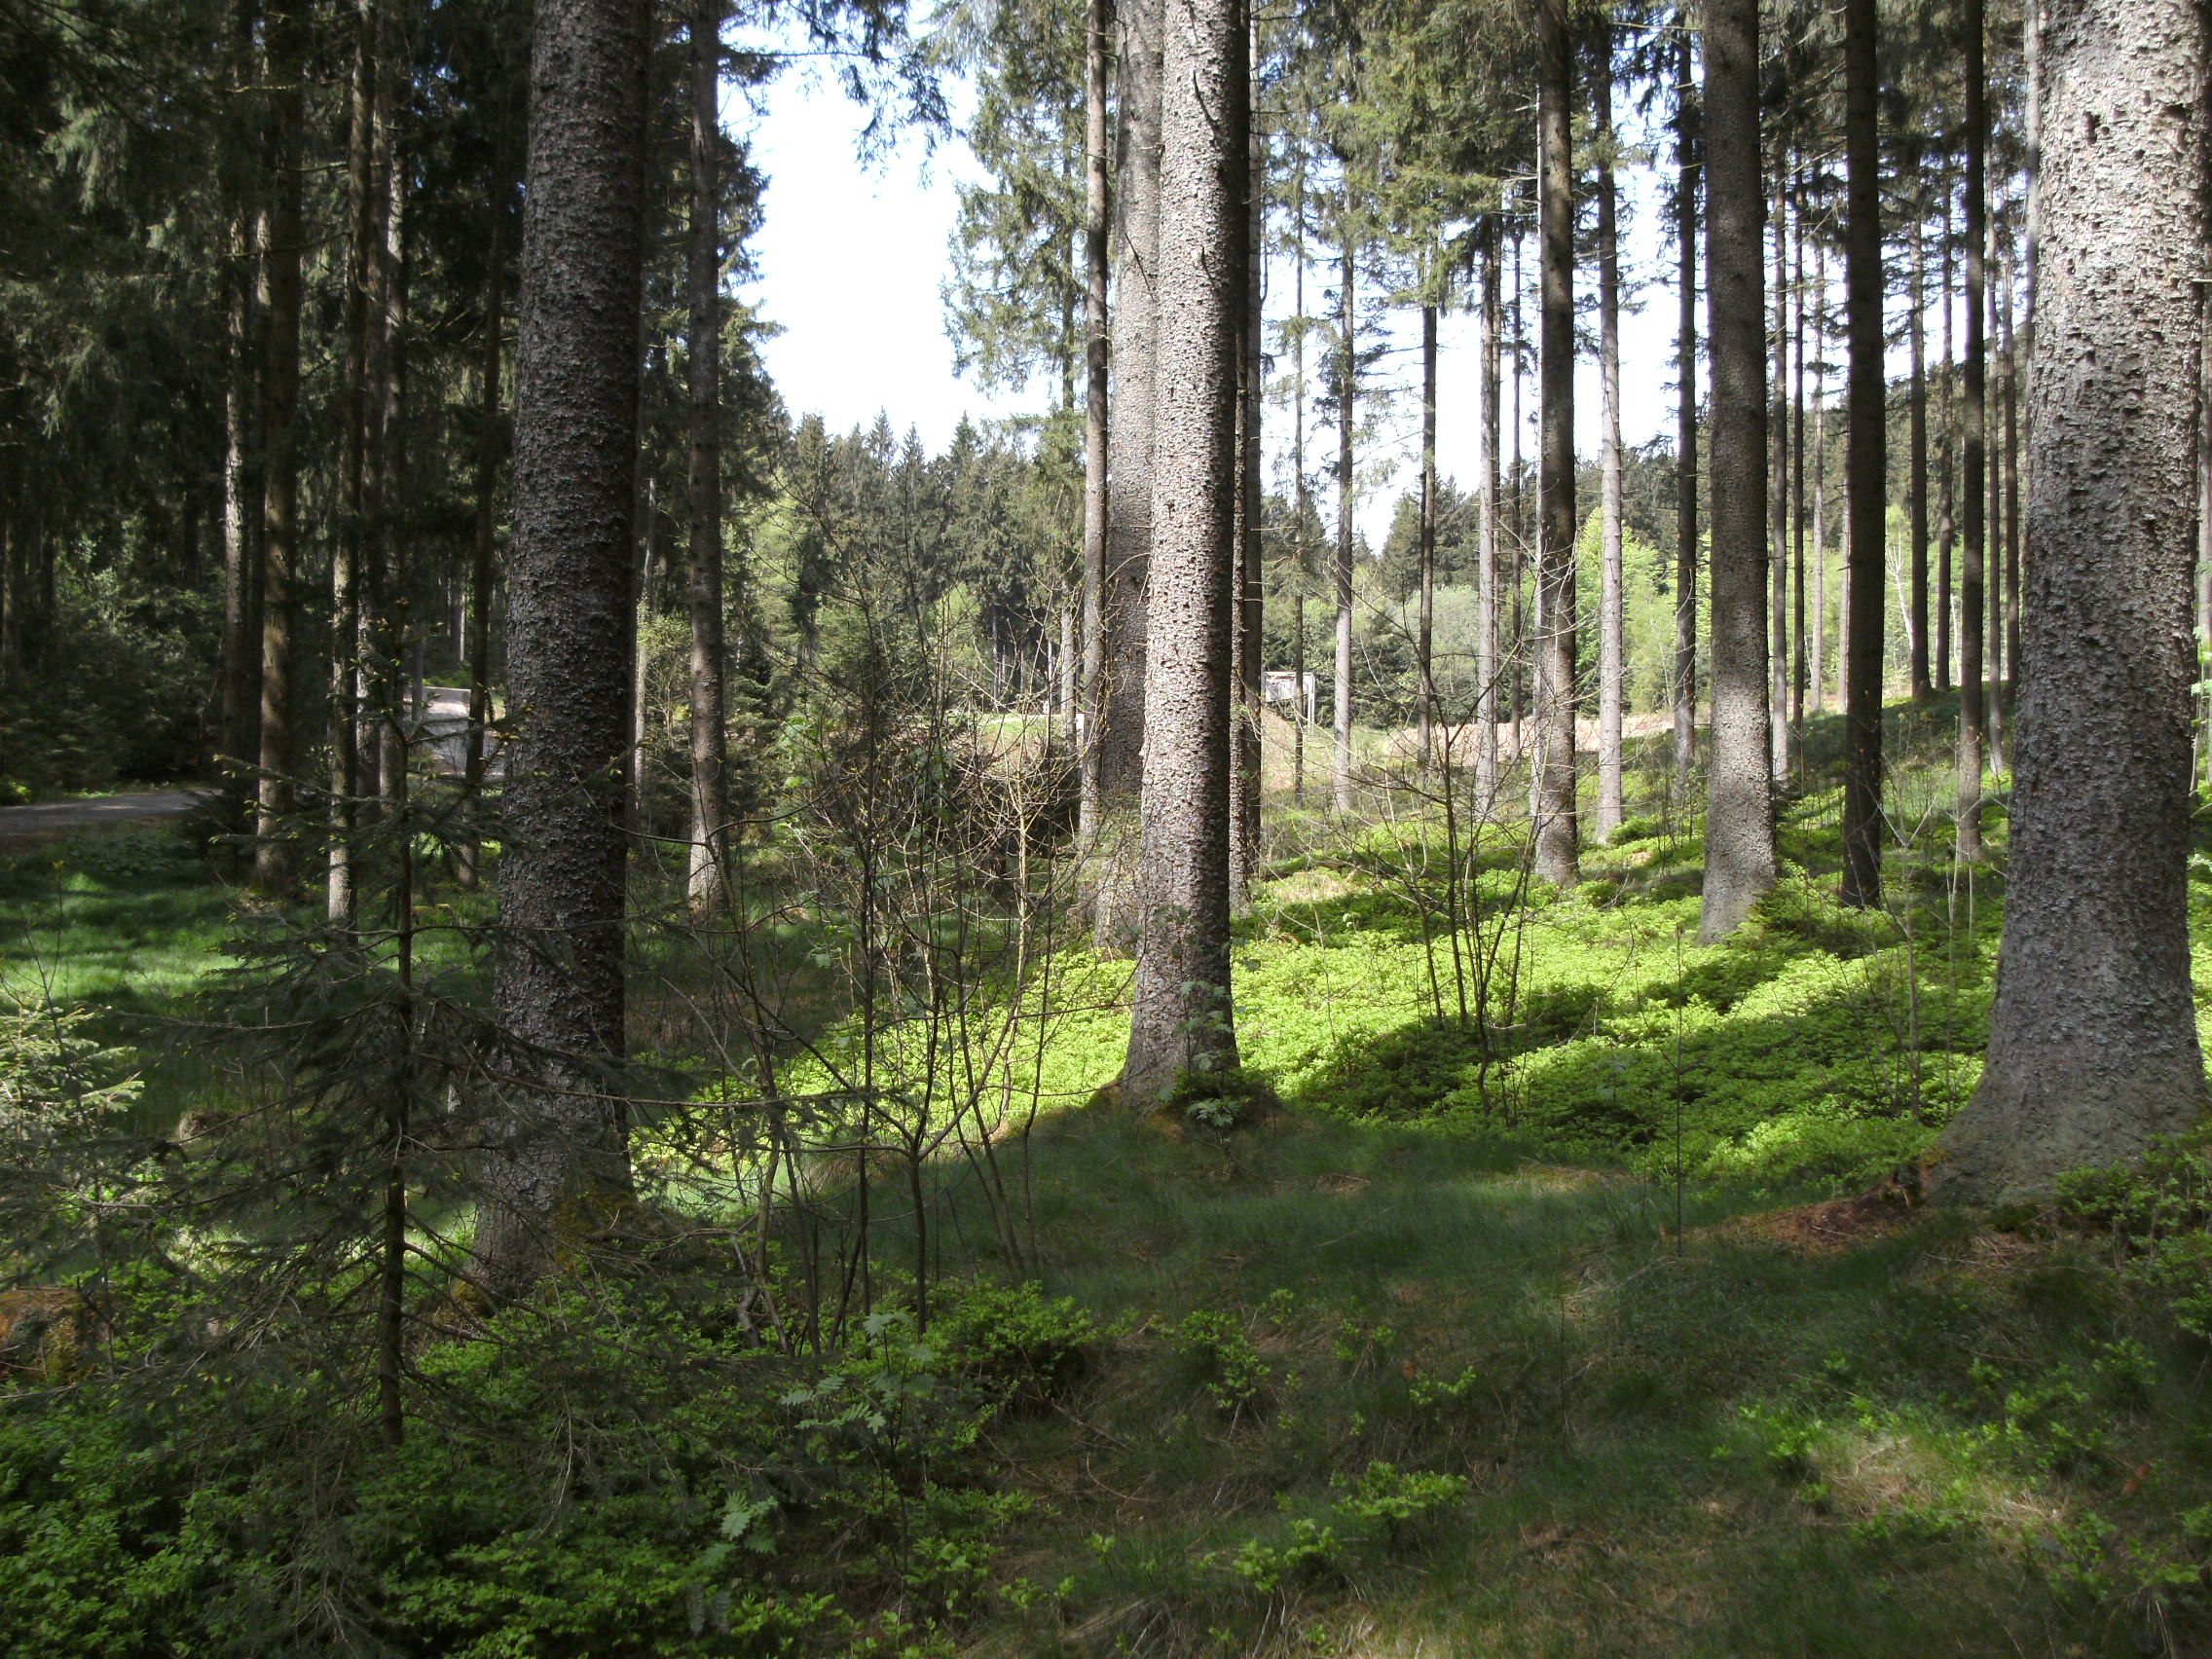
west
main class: Woodland
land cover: Spruce dominated coniferous woodland
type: hemiboreal forest and nemoral coniferous forest and mixed broadleaved-coniferous forest
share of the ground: 50 - 75 %
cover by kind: coniferous forest trees 70 %, herbaceous plants 20 %, shrubs 10 %
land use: Forestry
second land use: Sport
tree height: > 5 m
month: May
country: AT
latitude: 48.1000
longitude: 13.3696
